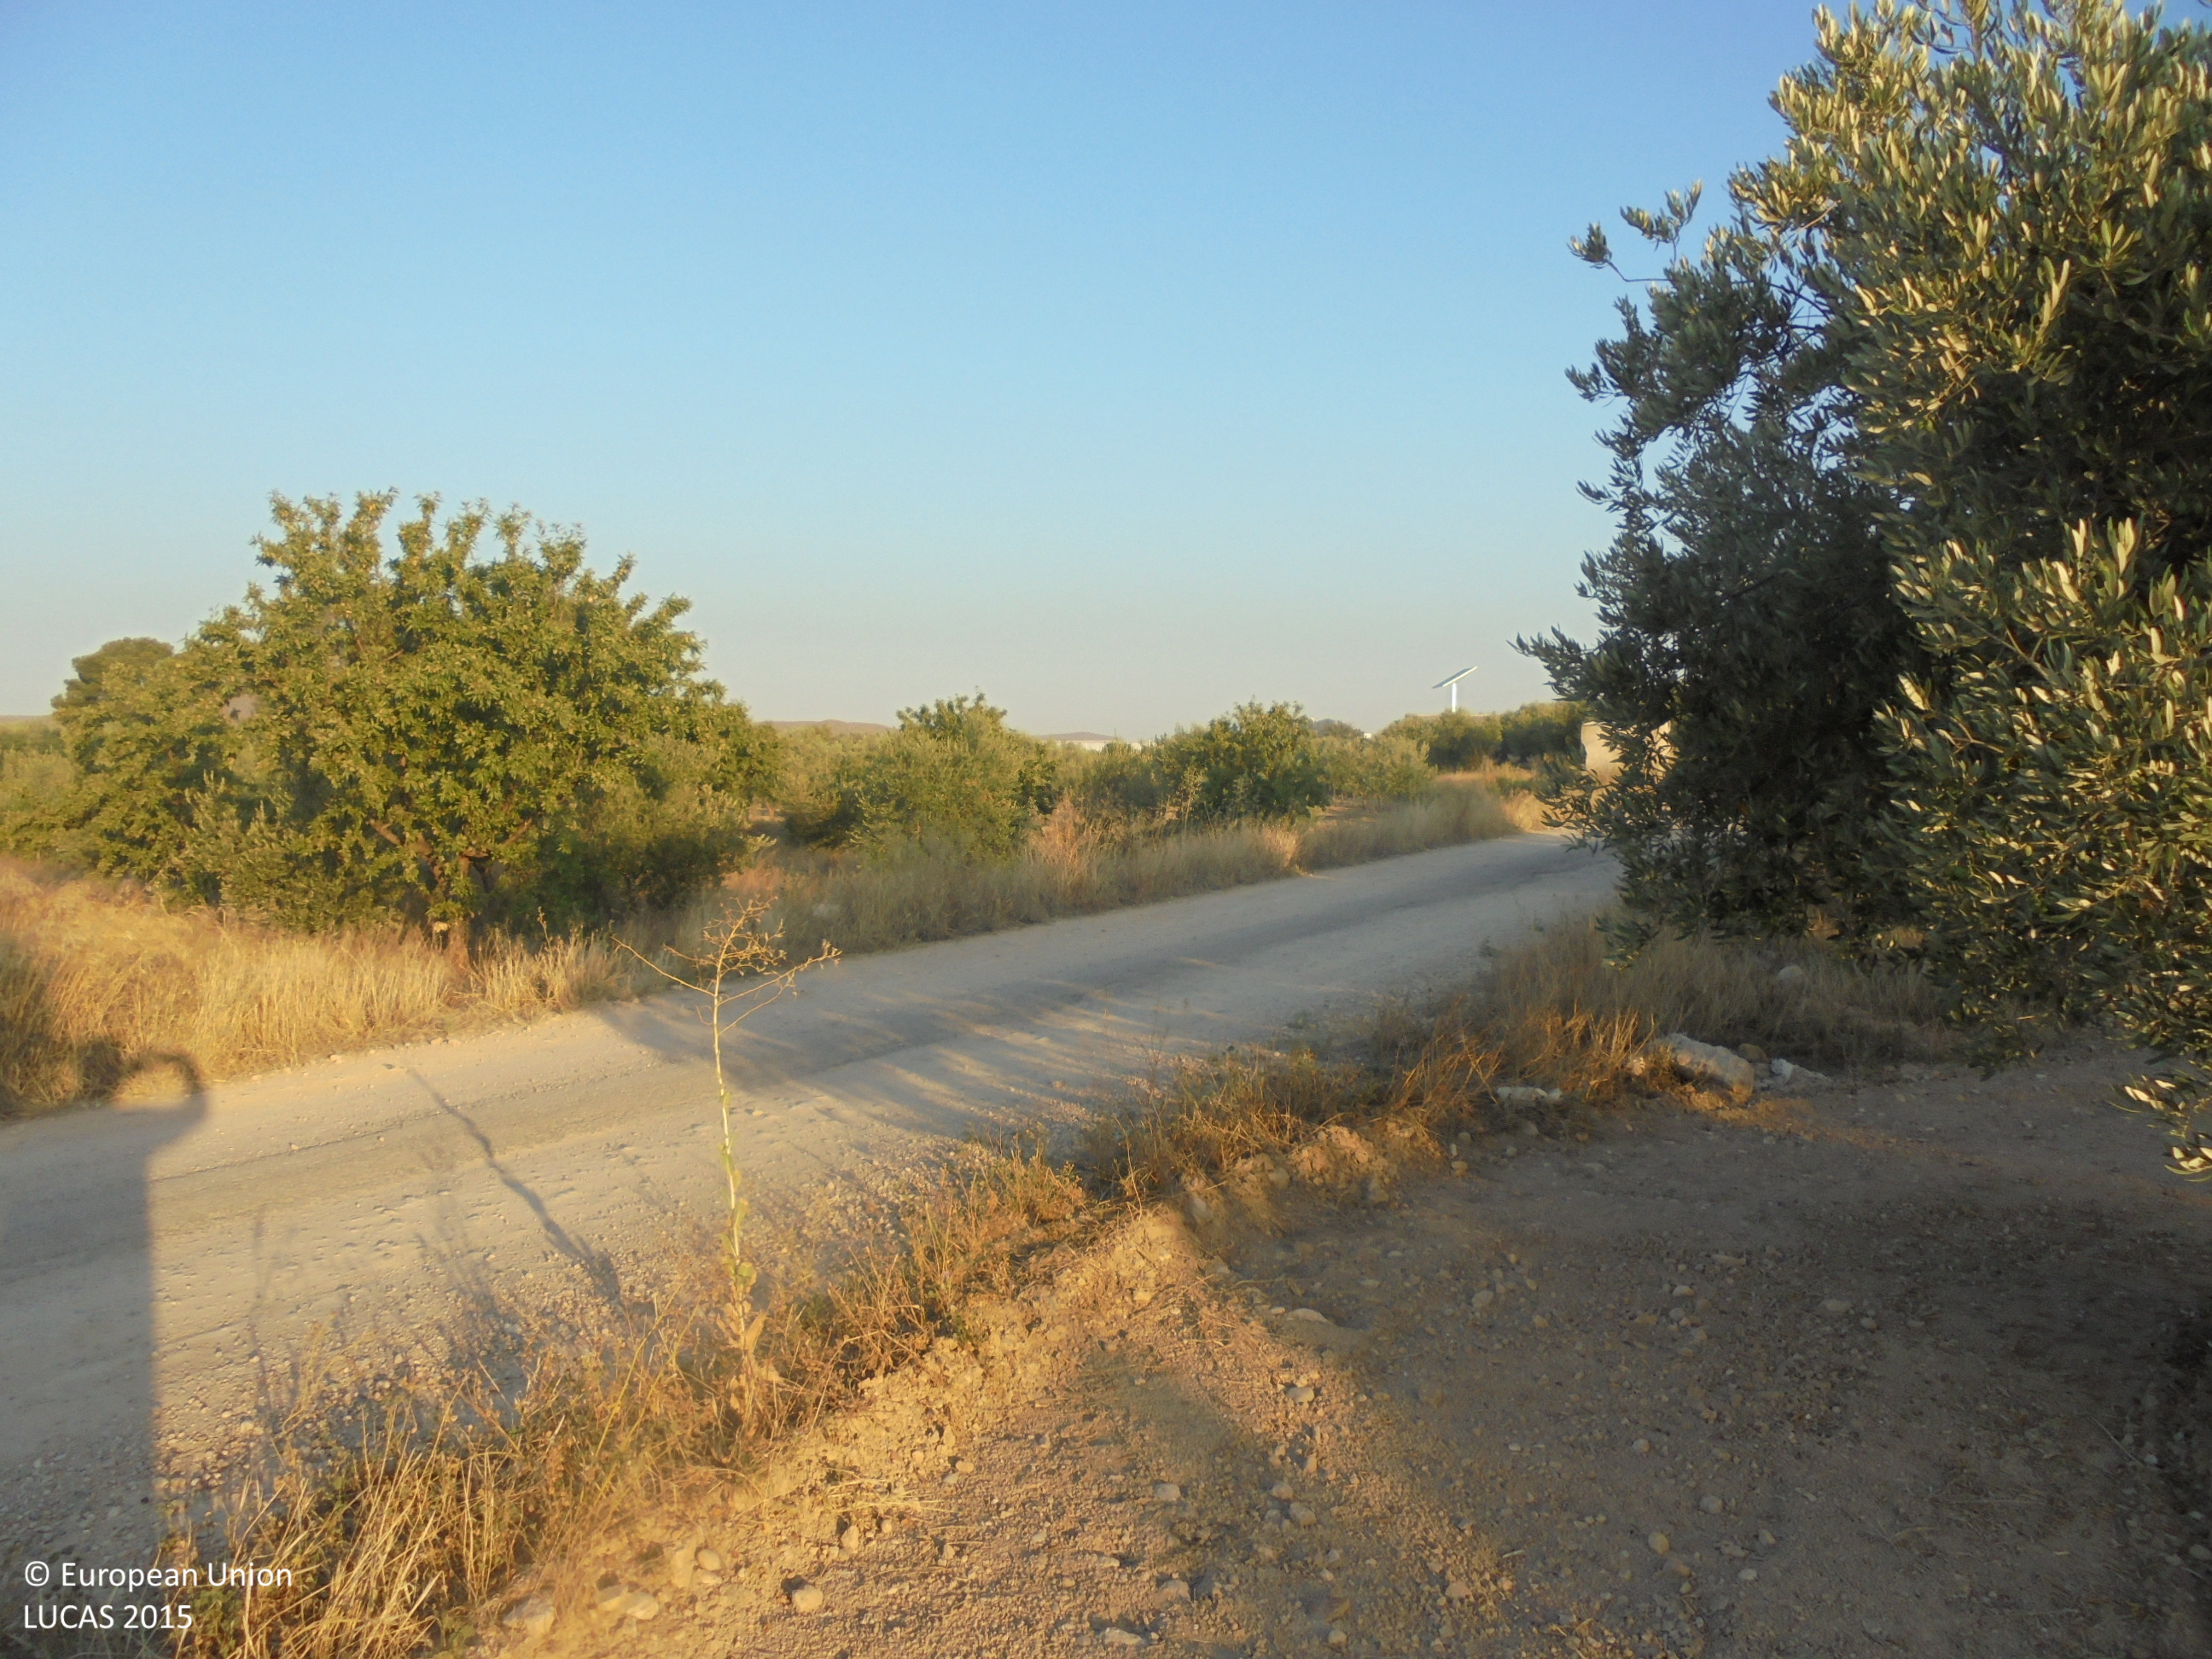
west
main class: Cropland
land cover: Olive groves
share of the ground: 25 - 50 %
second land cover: Other bare soil
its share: > 75 %
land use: Agriculture (excluding fallow land and kitchen gardens)
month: July
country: ES
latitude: 38.5817
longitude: -1.6686
